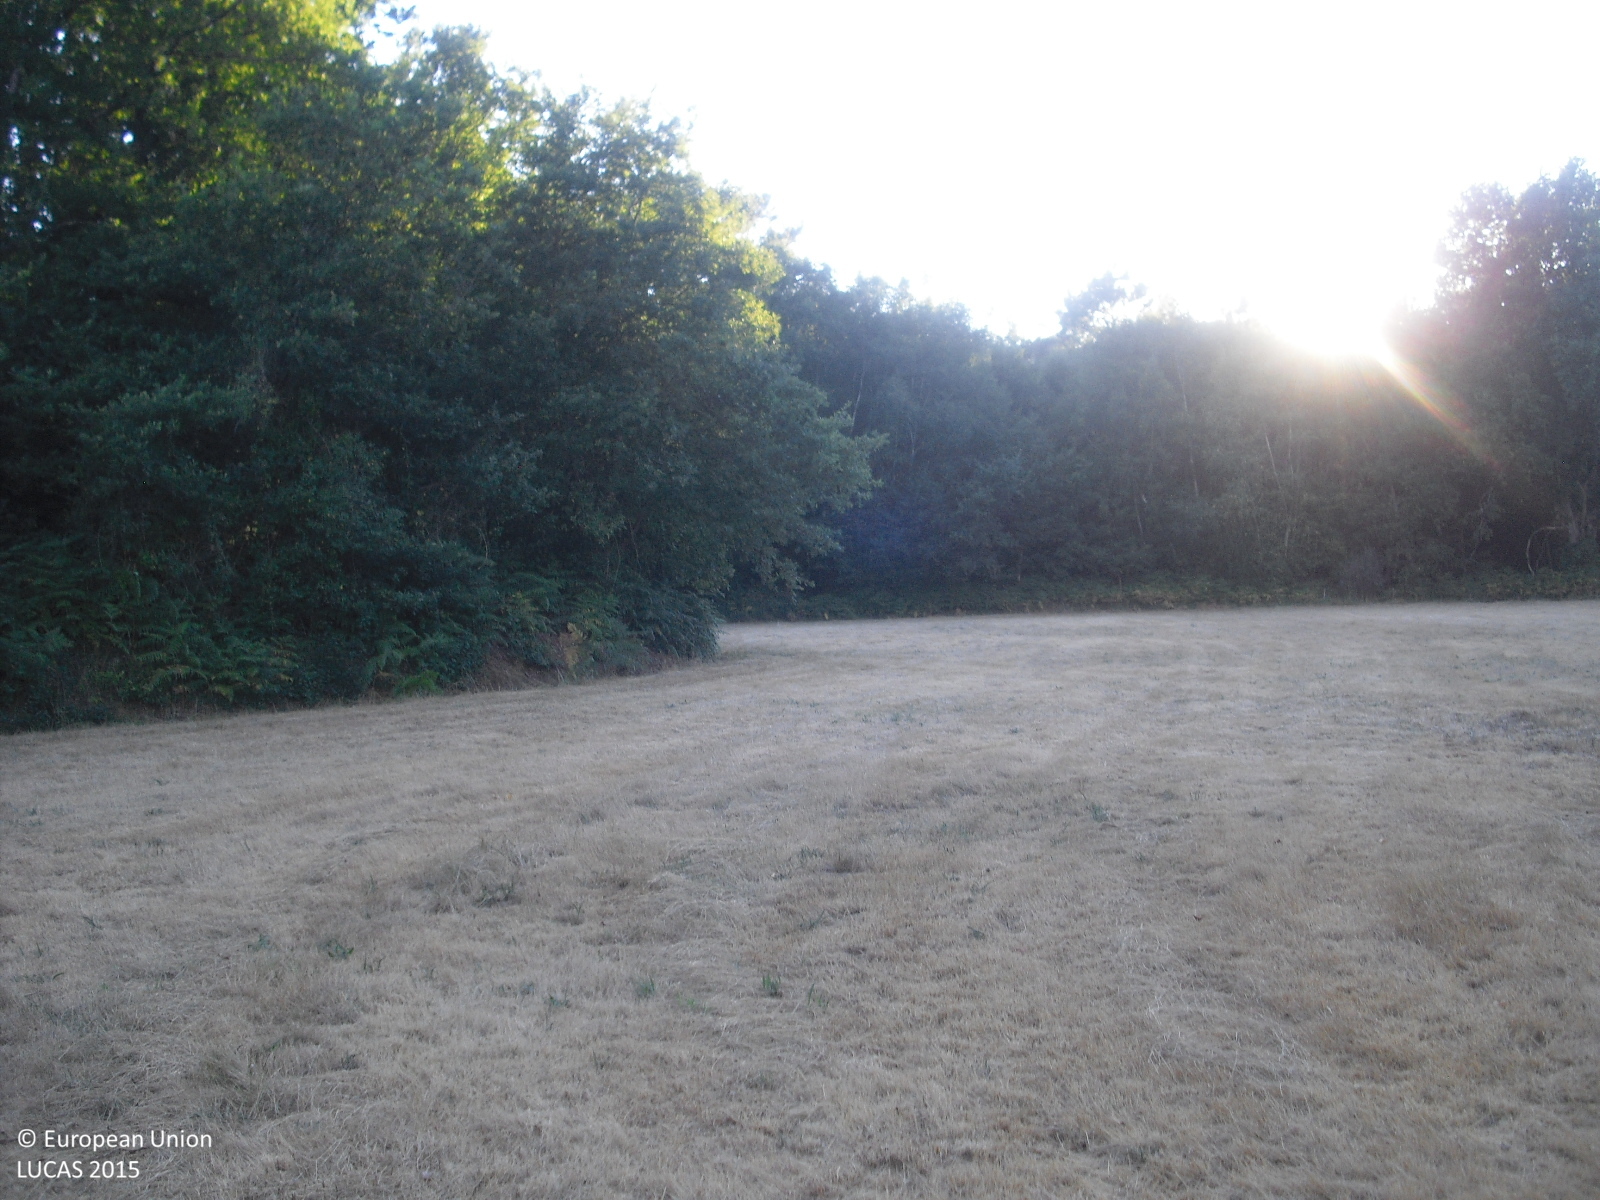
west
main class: Grassland
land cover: Grassland without tree/shrub cover
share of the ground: > 75 %
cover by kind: herbaceous plants 100 %
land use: Agriculture (excluding fallow land and kitchen gardens)
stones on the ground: < 10 %
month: July
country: ES
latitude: 42.2585
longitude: -7.6094
